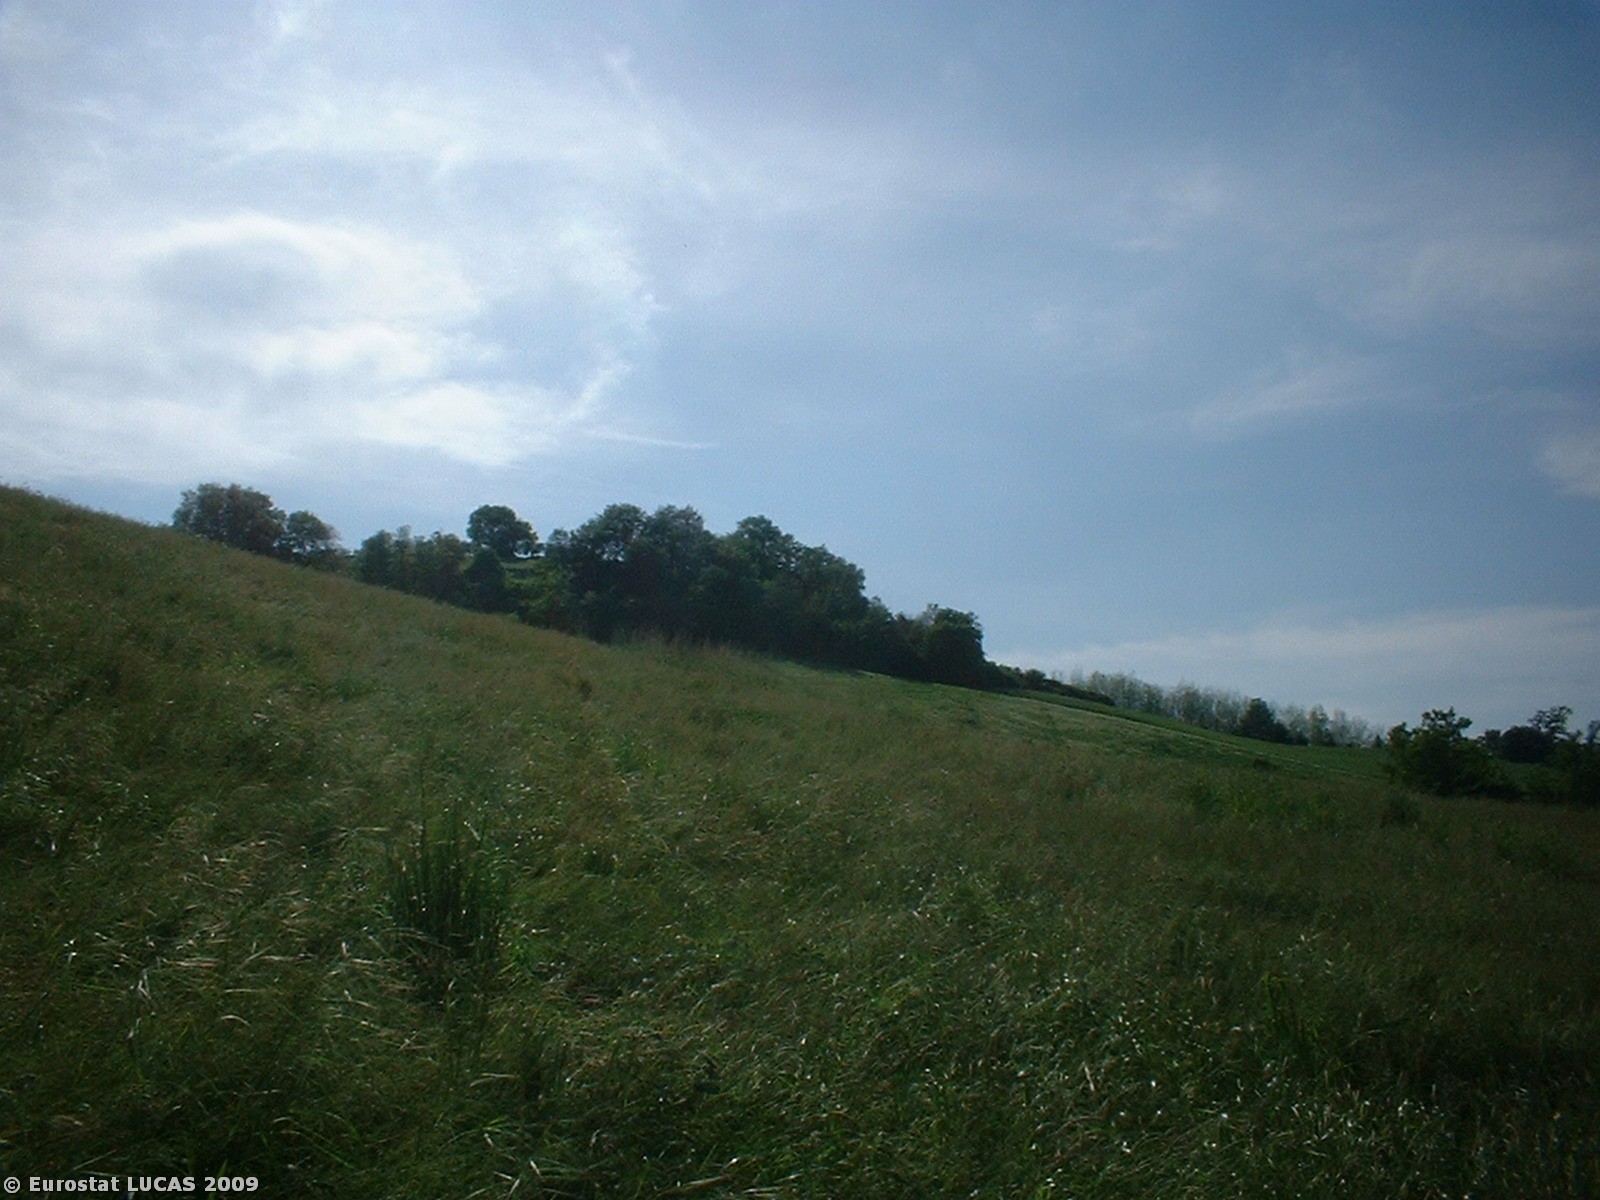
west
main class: Cropland
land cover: Temporary grasslands
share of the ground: > 75 %
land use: Agriculture (excluding fallow land and kitchen gardens)
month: May
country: IT
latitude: 43.0010
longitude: 13.7314
